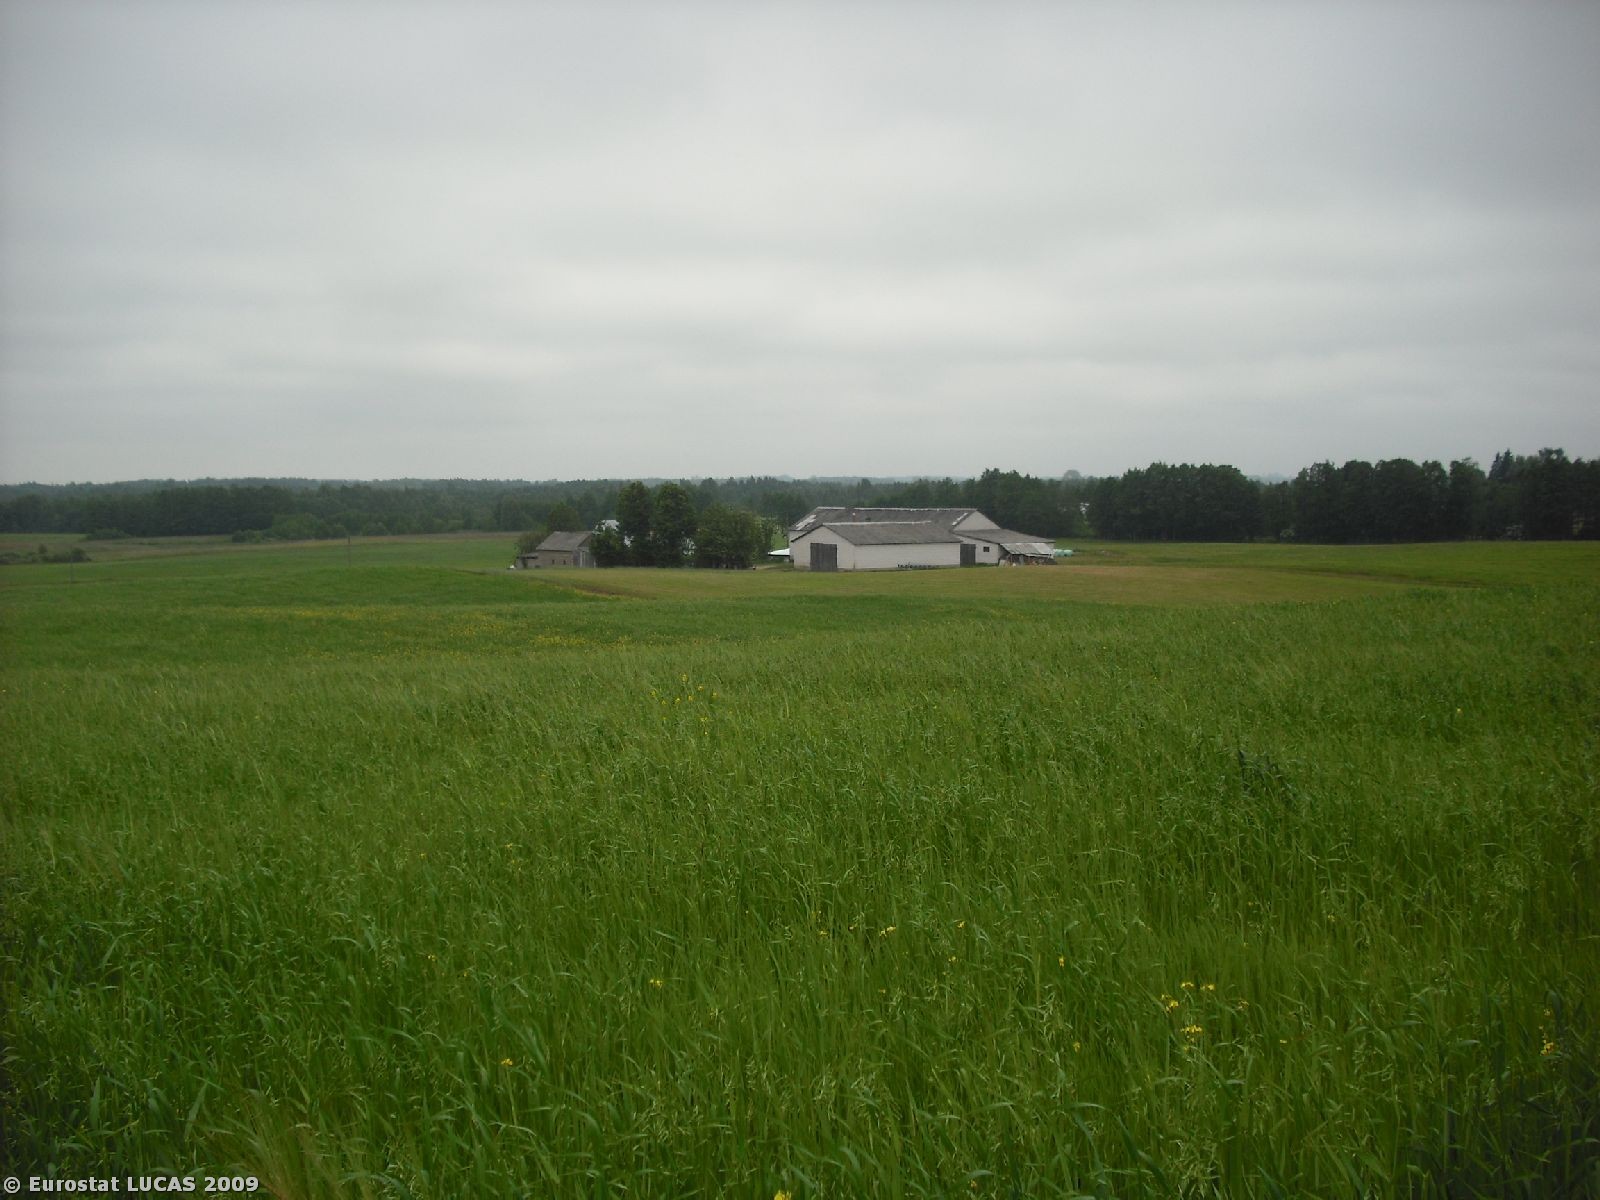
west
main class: Cropland
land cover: Oats
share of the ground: > 75 %
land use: Agriculture (excluding fallow land and kitchen gardens)
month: June
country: PL
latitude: 54.1026
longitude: 22.8092
